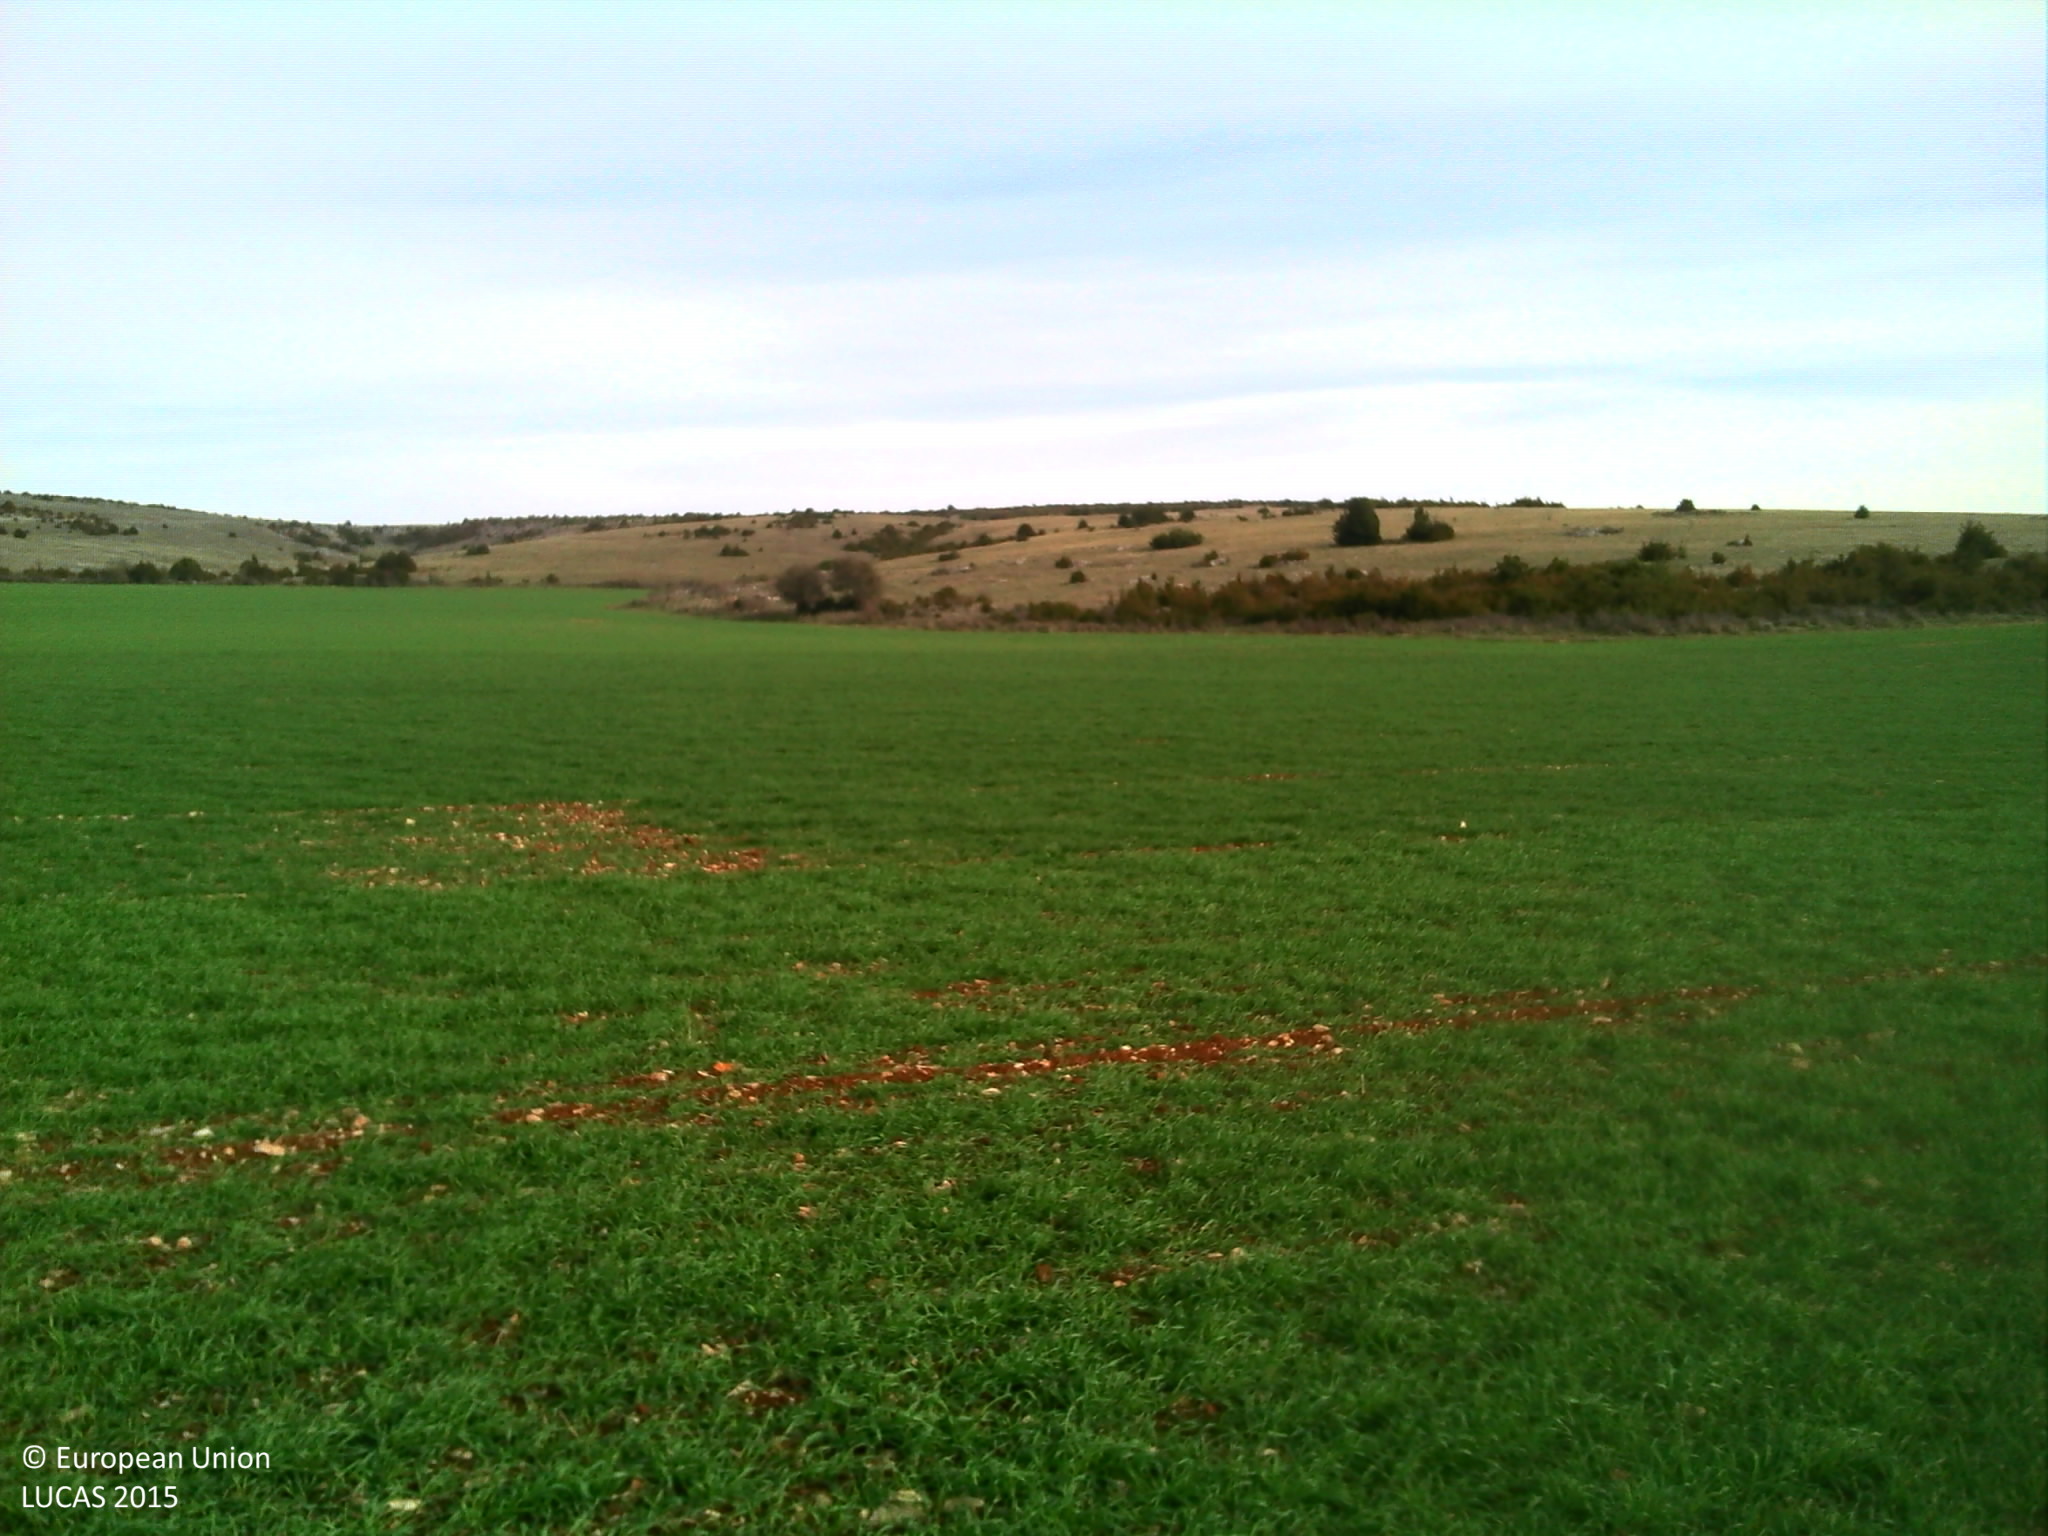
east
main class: Cropland
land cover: Barley
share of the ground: > 75 %
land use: Agriculture (excluding fallow land and kitchen gardens)
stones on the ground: 25 - 50 %
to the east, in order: Barley; Grass margins; Shrubland without tree cover; Single bushes/trees; Shrubland without tree cover; Fences; Grassland without tree/shrub cover; Rocks and stones; Grassland without tree/shrub cover
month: November
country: FR
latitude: 44.0487
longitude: 3.1041
